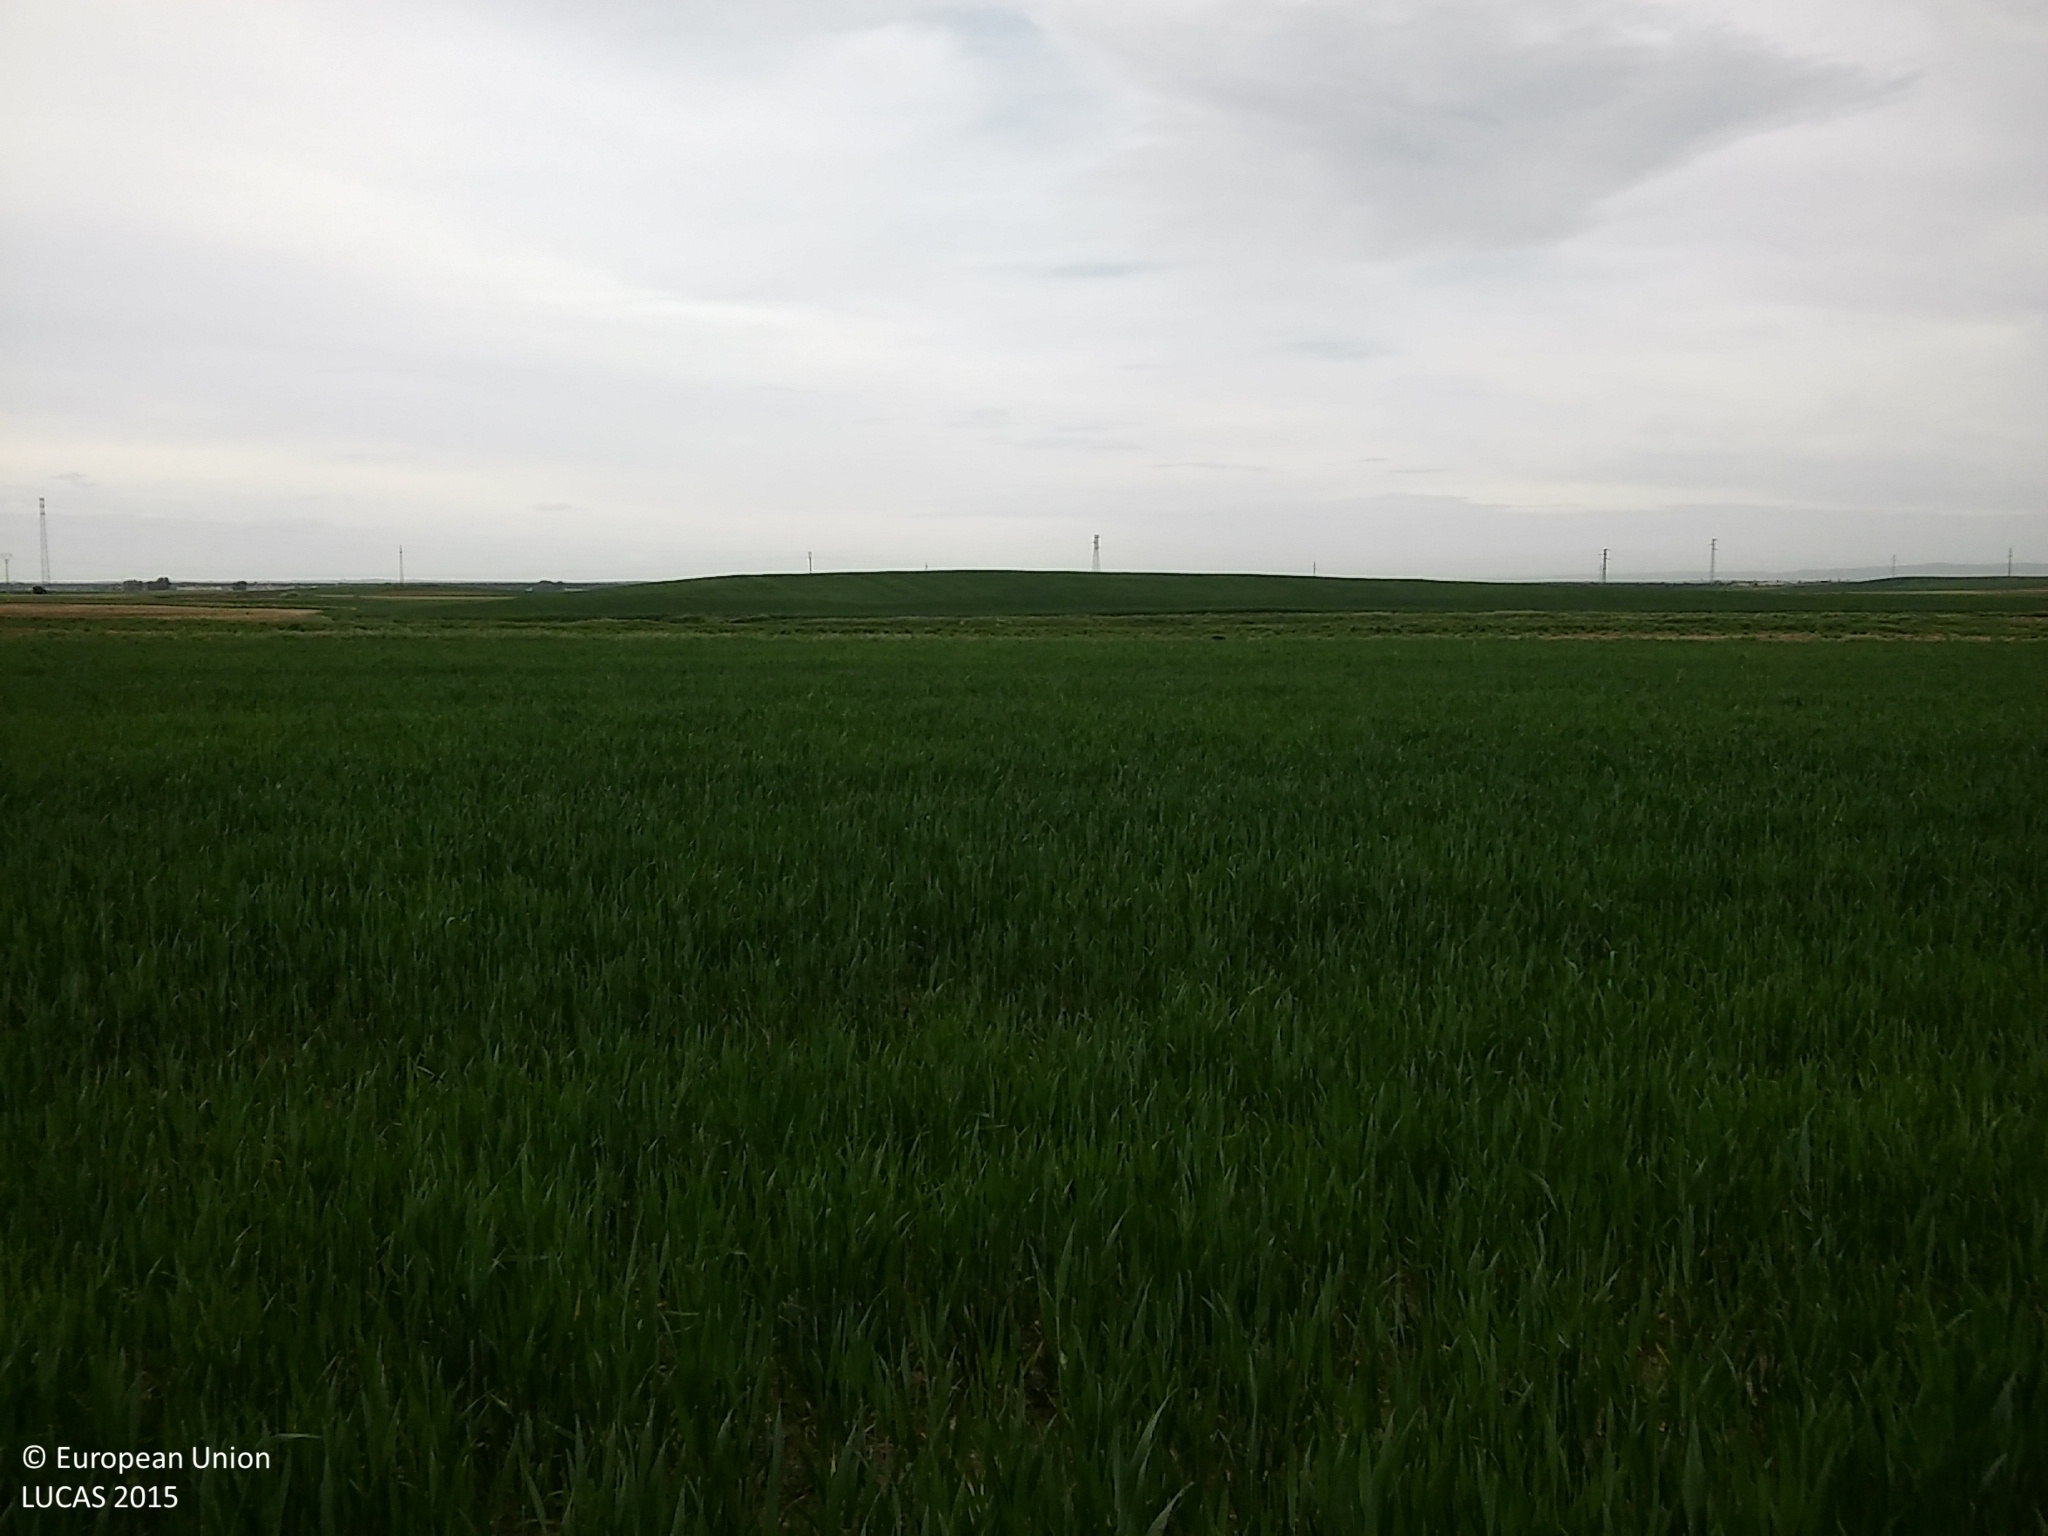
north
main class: Cropland
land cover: Common wheat
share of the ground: 50 - 75 %
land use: Agriculture (excluding fallow land and kitchen gardens)
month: May
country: ES
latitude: 41.1559
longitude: -4.0540
